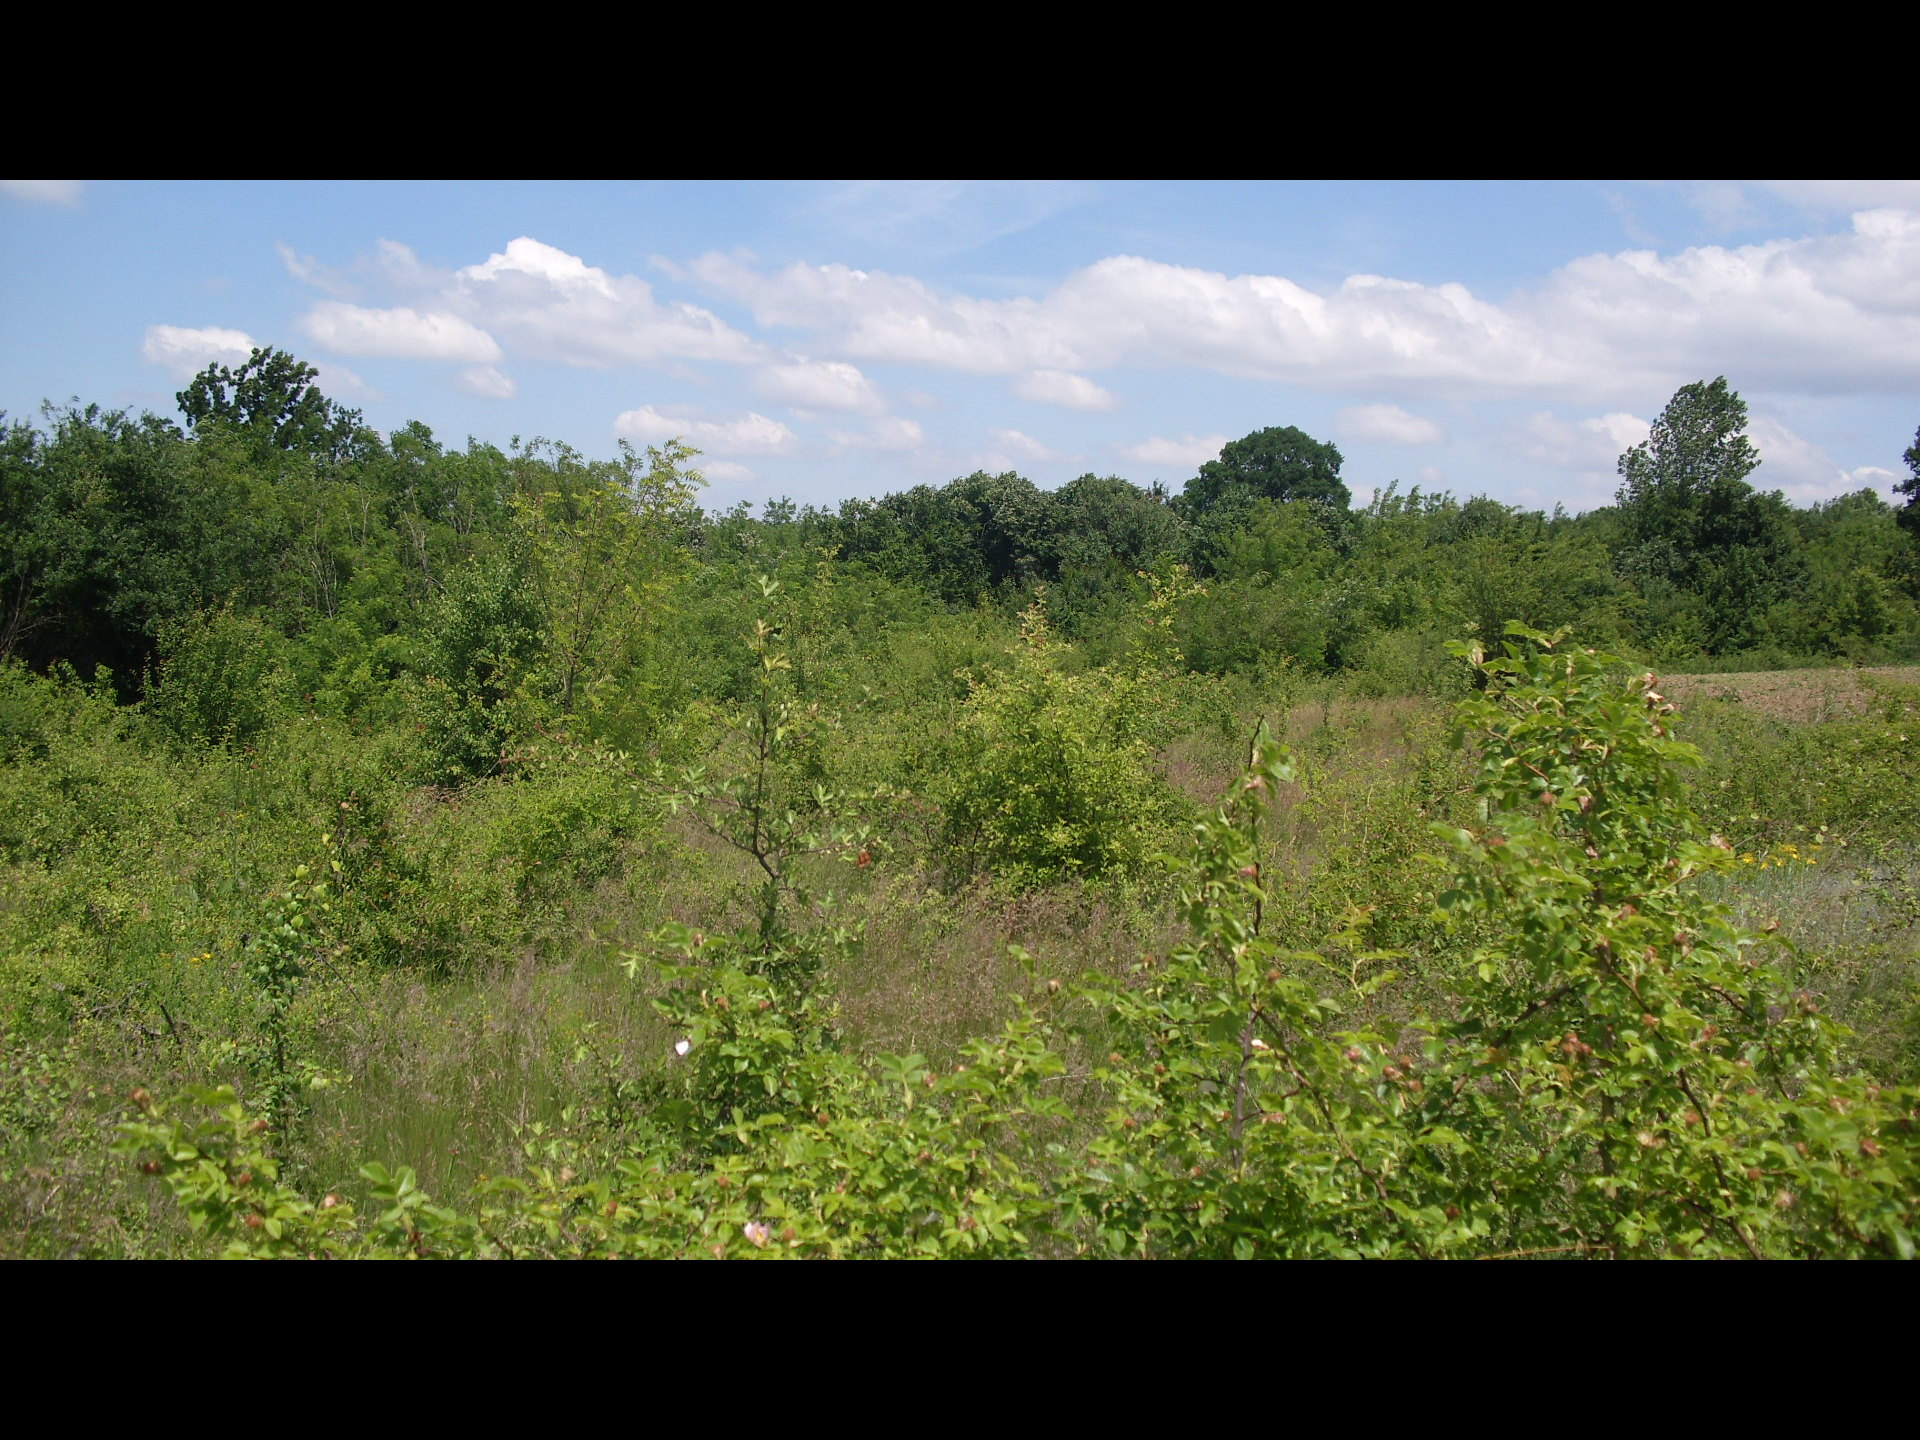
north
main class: Grassland
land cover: Grassland with sparse tree/shrub cover
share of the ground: > 75 %
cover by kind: herbaceous plants 90 %, broadleaved forest trees 5 %, shrubs 5 %
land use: Semi-natural and natural areas not in use
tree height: < 5 m
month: May
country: BG
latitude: 43.3697
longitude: 23.3822
